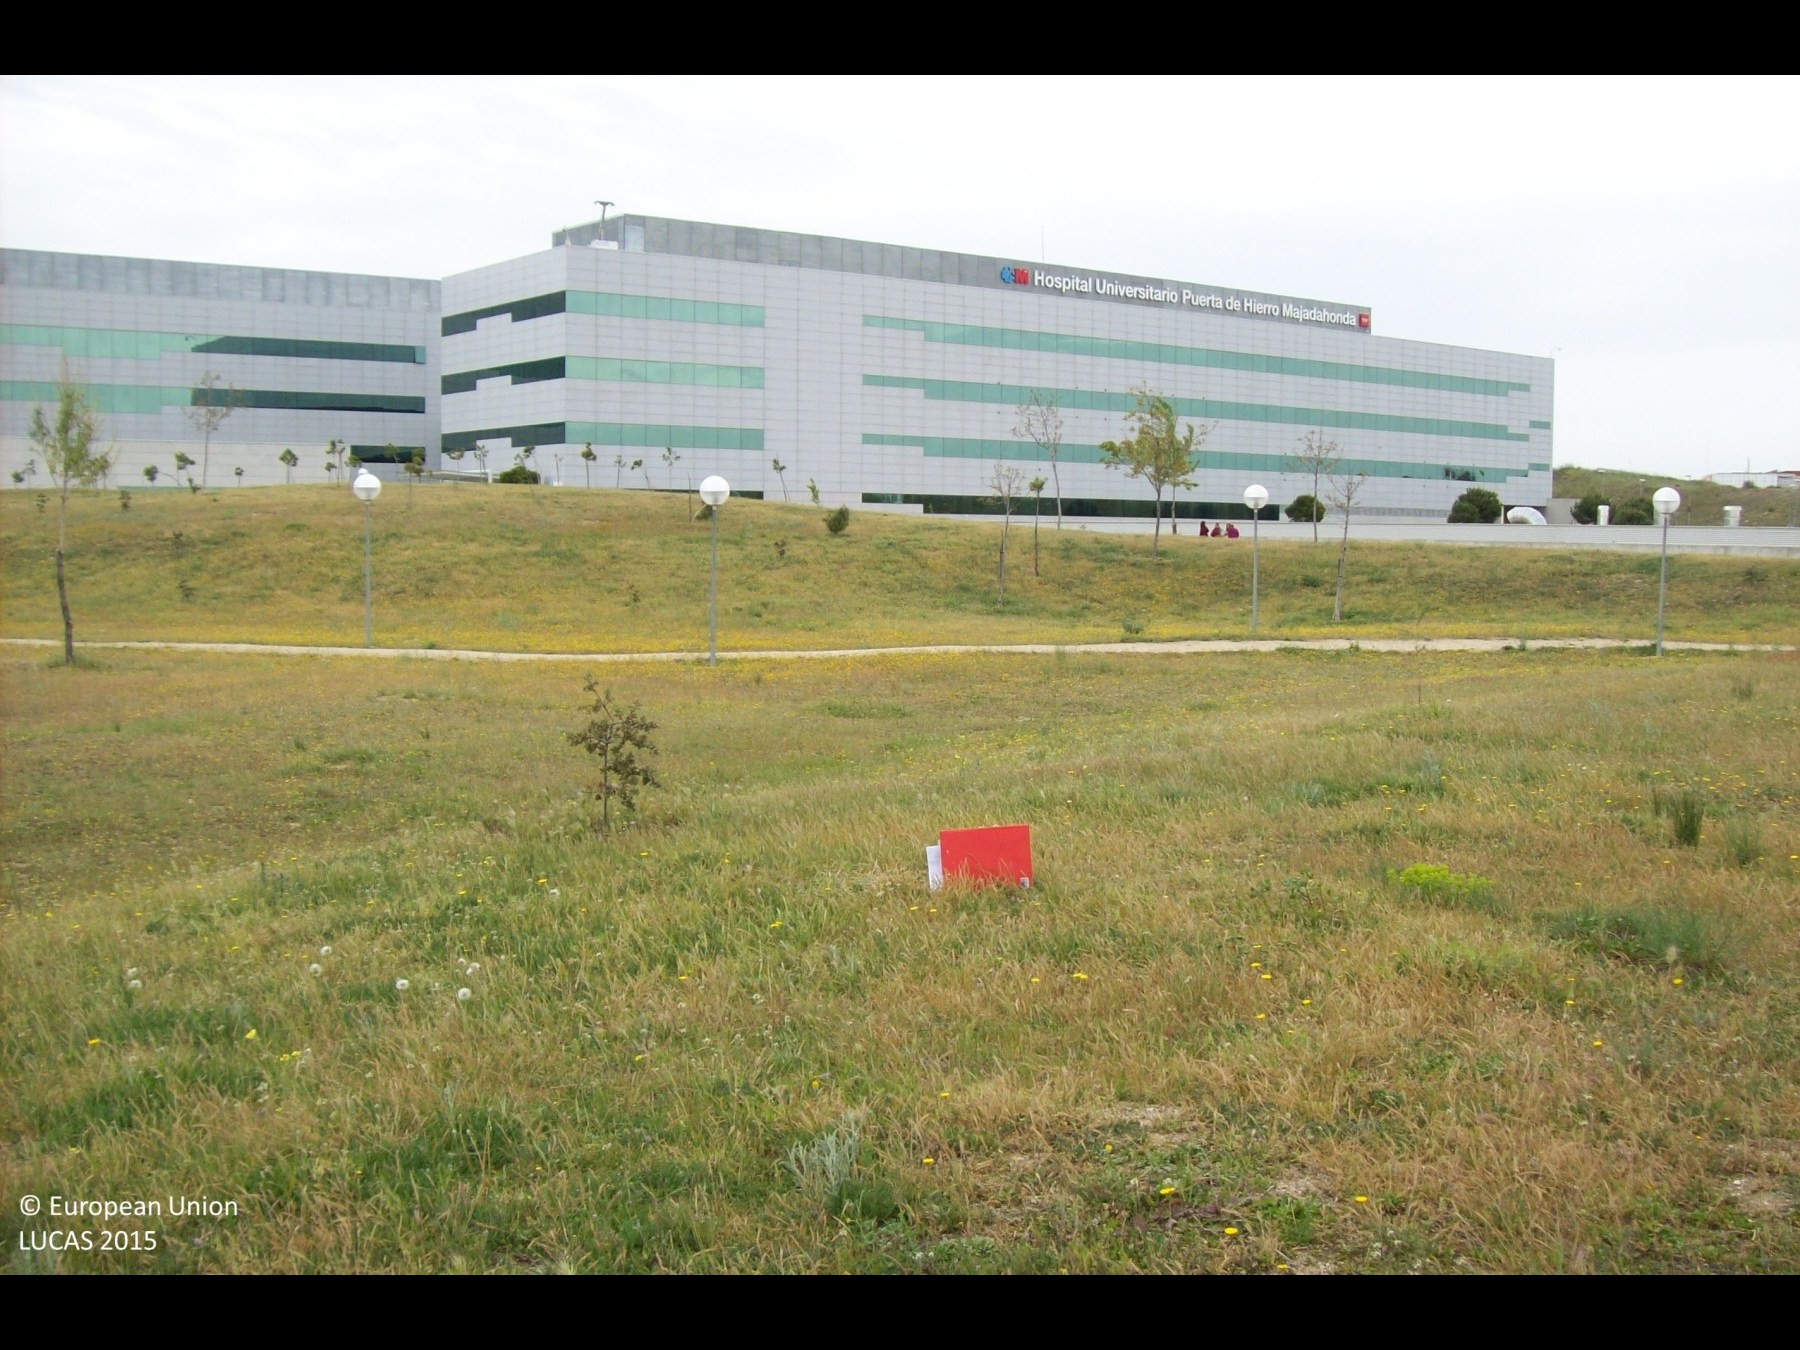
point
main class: Grassland
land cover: Grassland with sparse tree/shrub cover
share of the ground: > 75 %
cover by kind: herbaceous plants 95 %, coniferous forest trees 5 %
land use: Community services
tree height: < 5 m
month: April
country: ES
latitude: 40.4495
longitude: -3.8710
